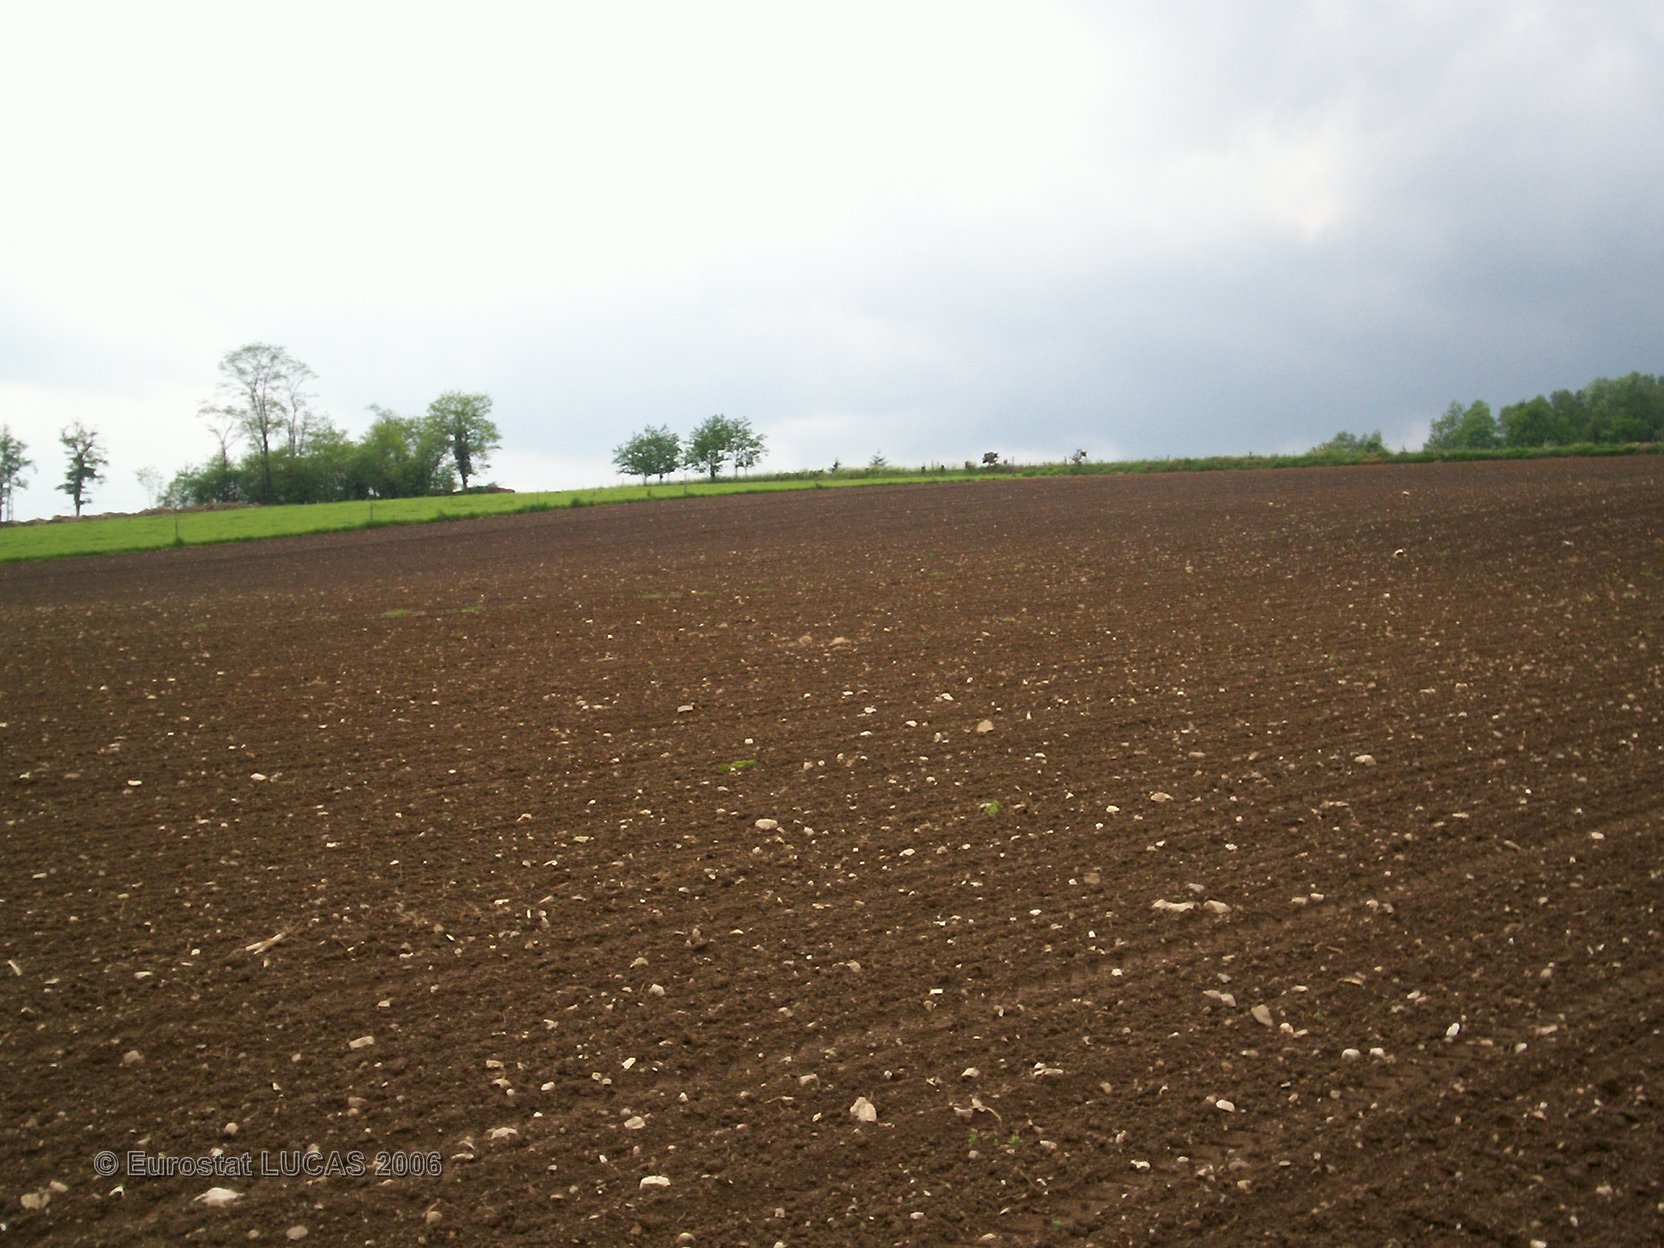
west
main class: Cropland
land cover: Maize
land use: Agriculture (excluding fallow land and kitchen gardens)
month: May
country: FR
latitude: 45.7340
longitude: 0.5667
